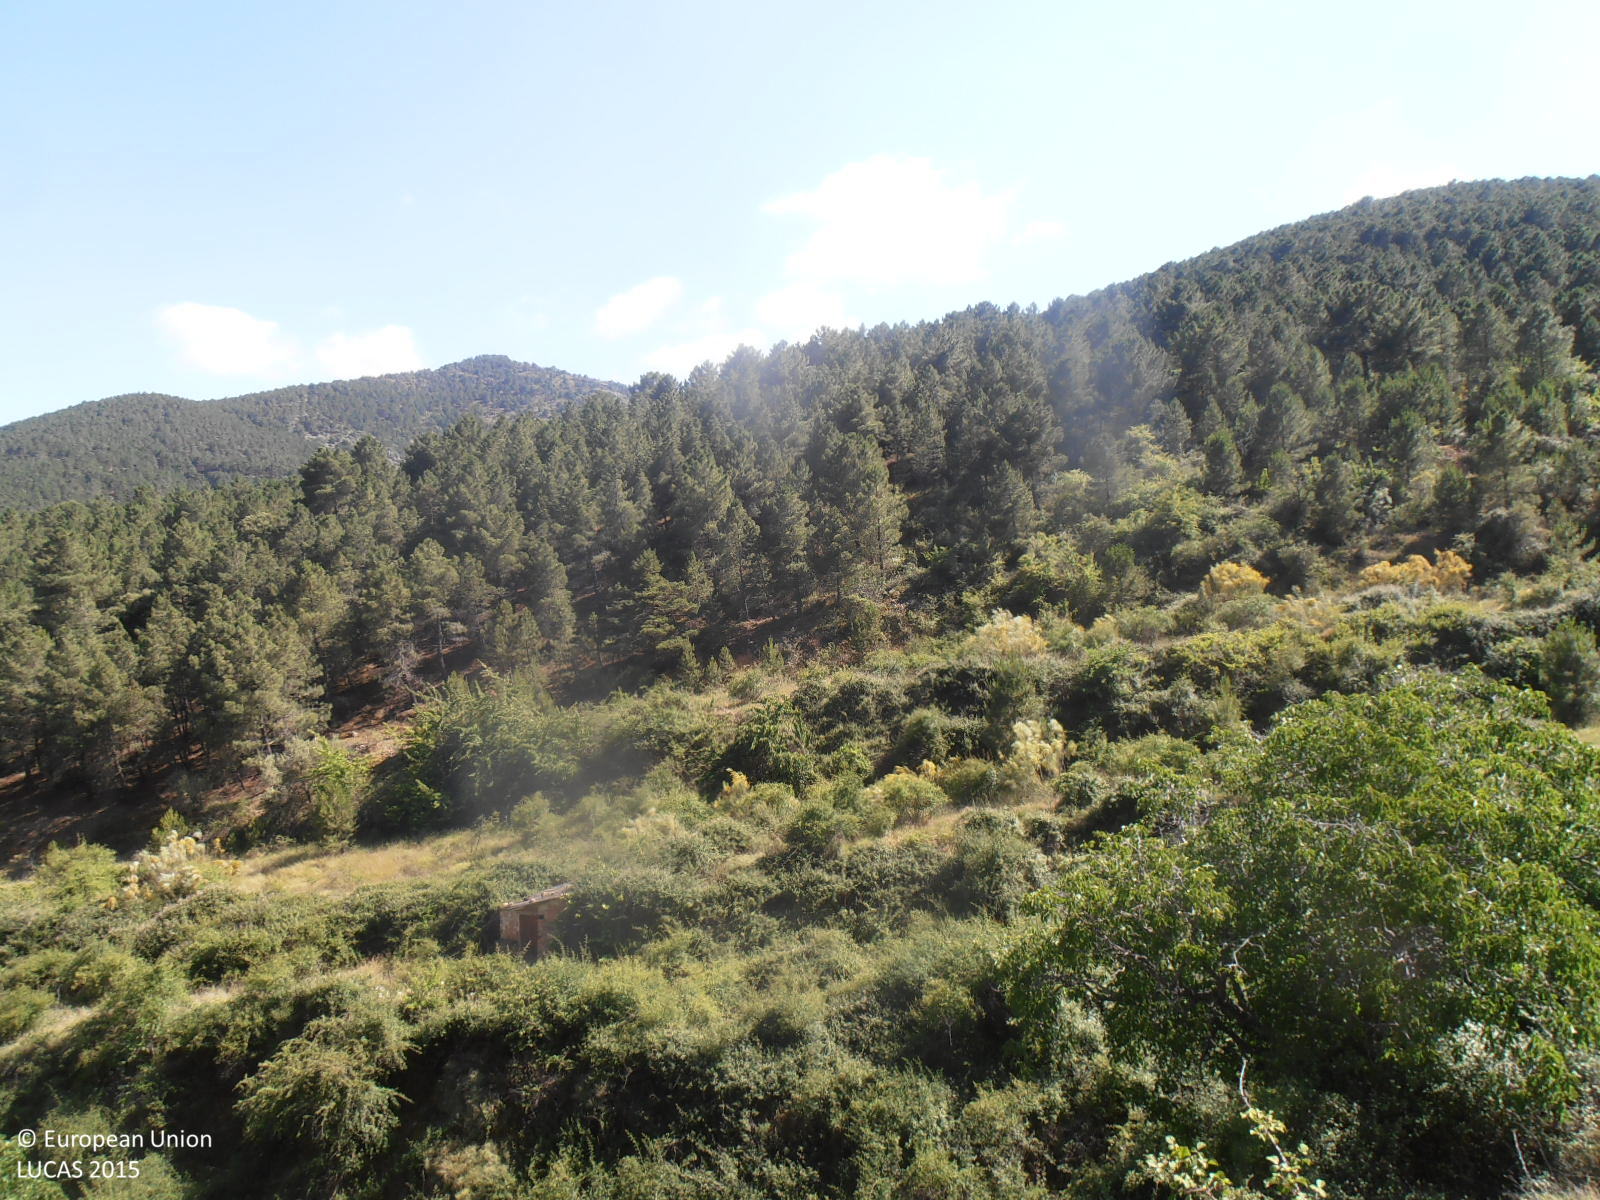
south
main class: Shrubland
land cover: Shrubland without tree cover
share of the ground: > 75 %
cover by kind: shrubs 100 %
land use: Abandoned areas
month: June
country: ES
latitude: 41.3326
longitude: -1.4102
